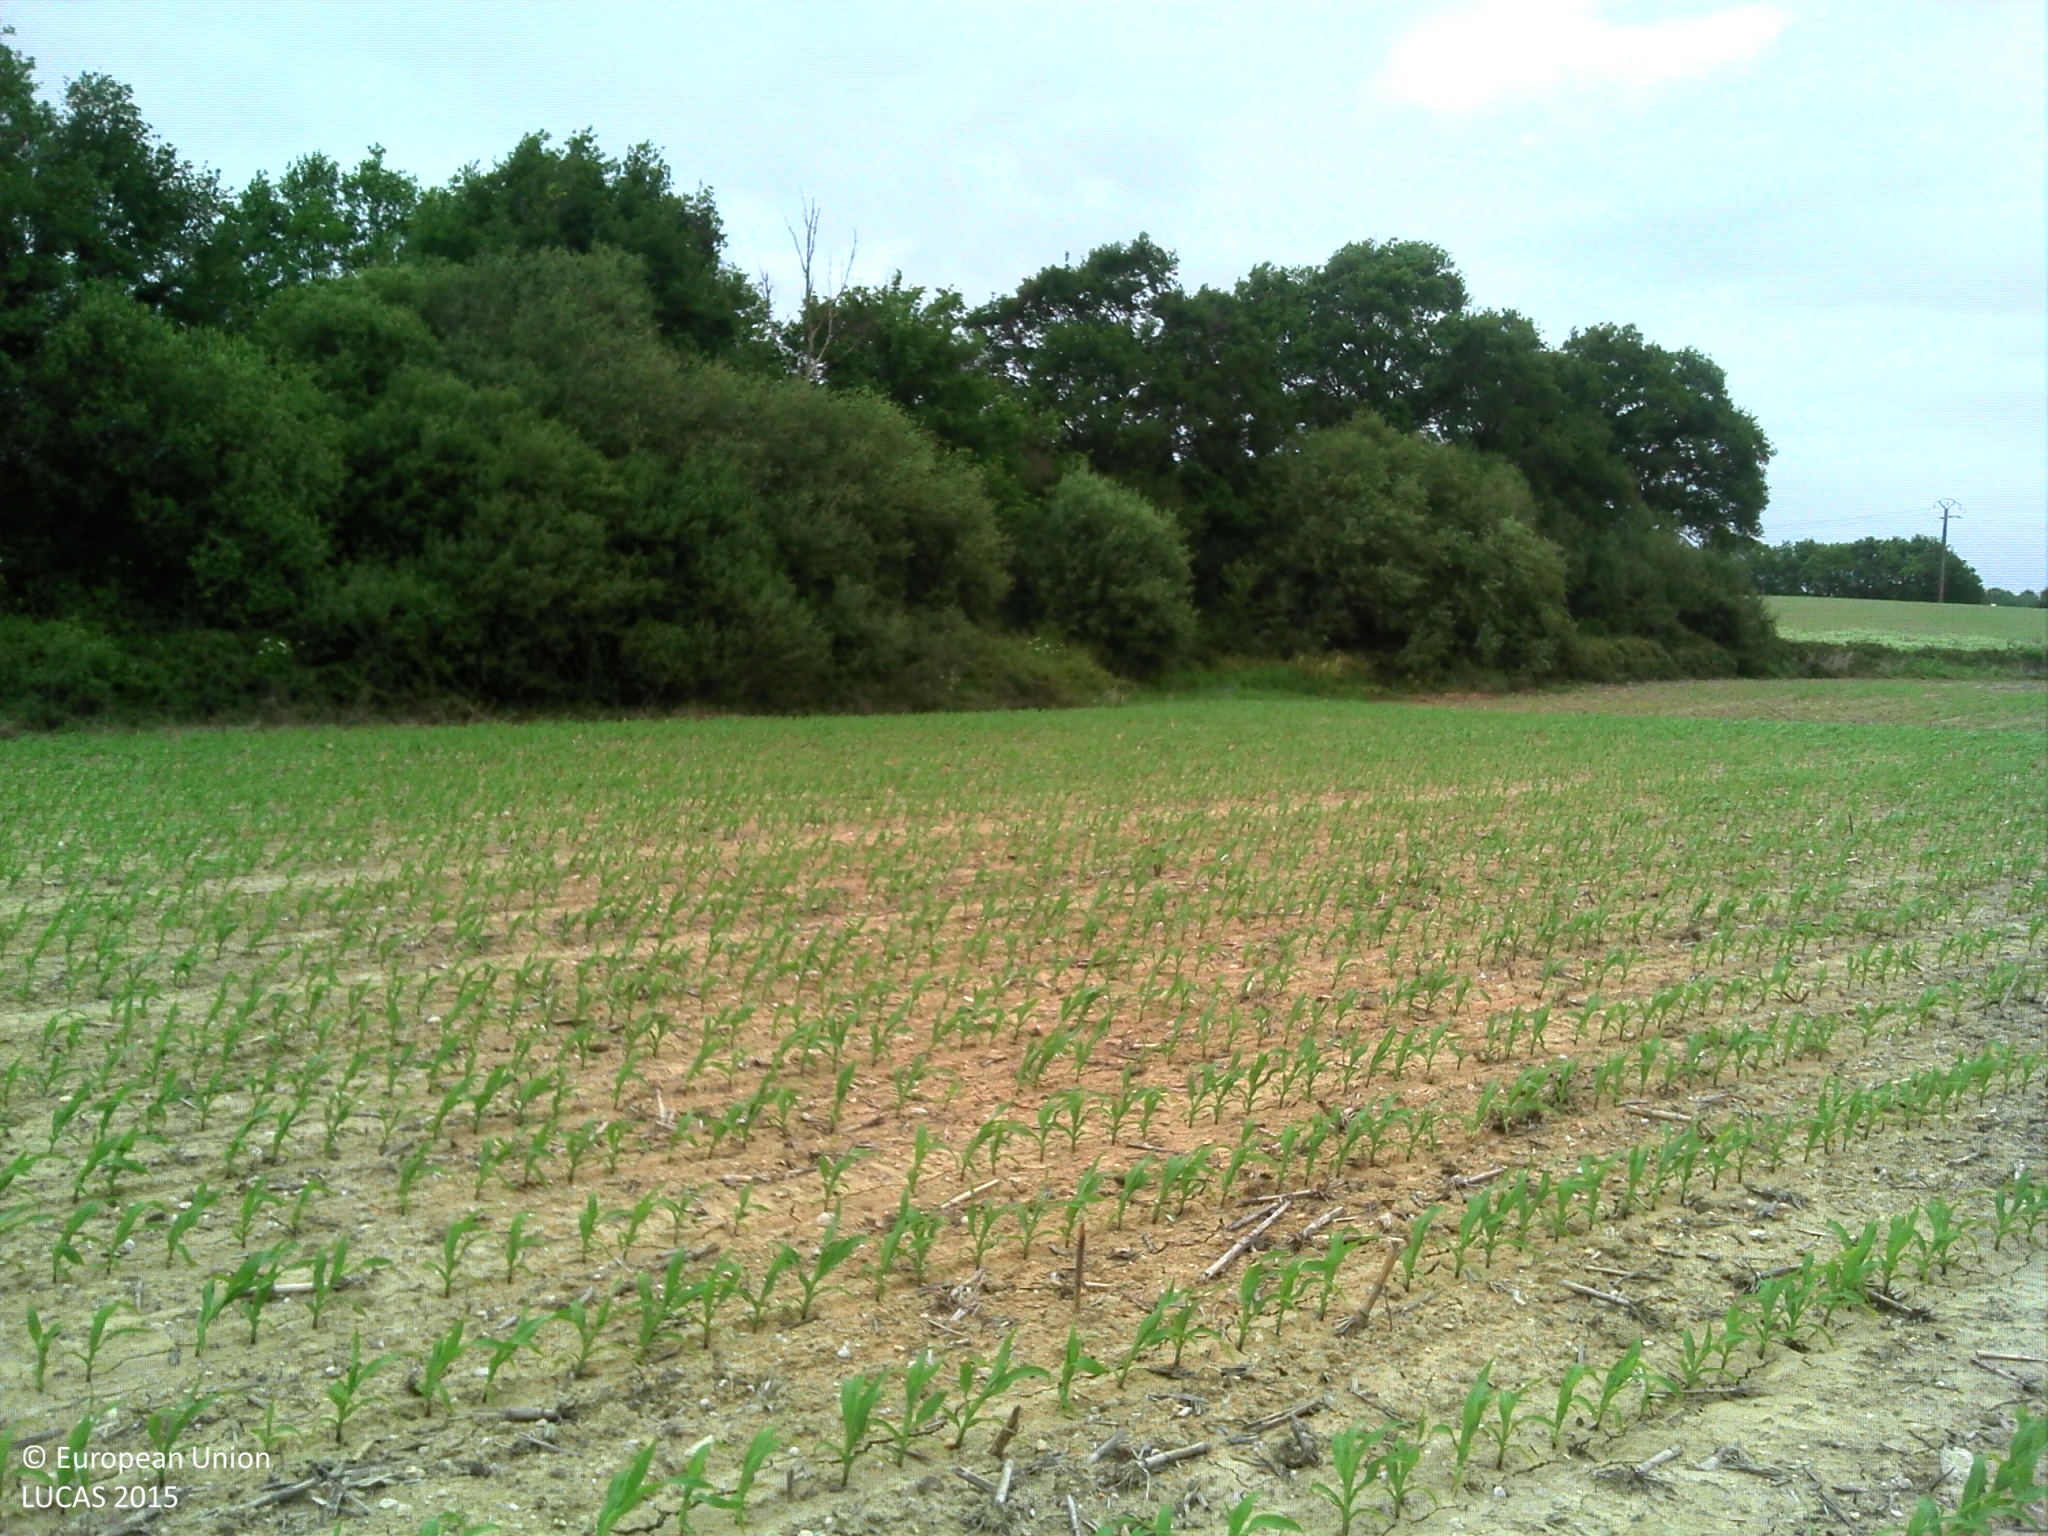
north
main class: Cropland
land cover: Maize
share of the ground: 10 - 25 %
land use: Agriculture (excluding fallow land and kitchen gardens)
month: June
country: FR
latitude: 46.8943
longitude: -1.8174
